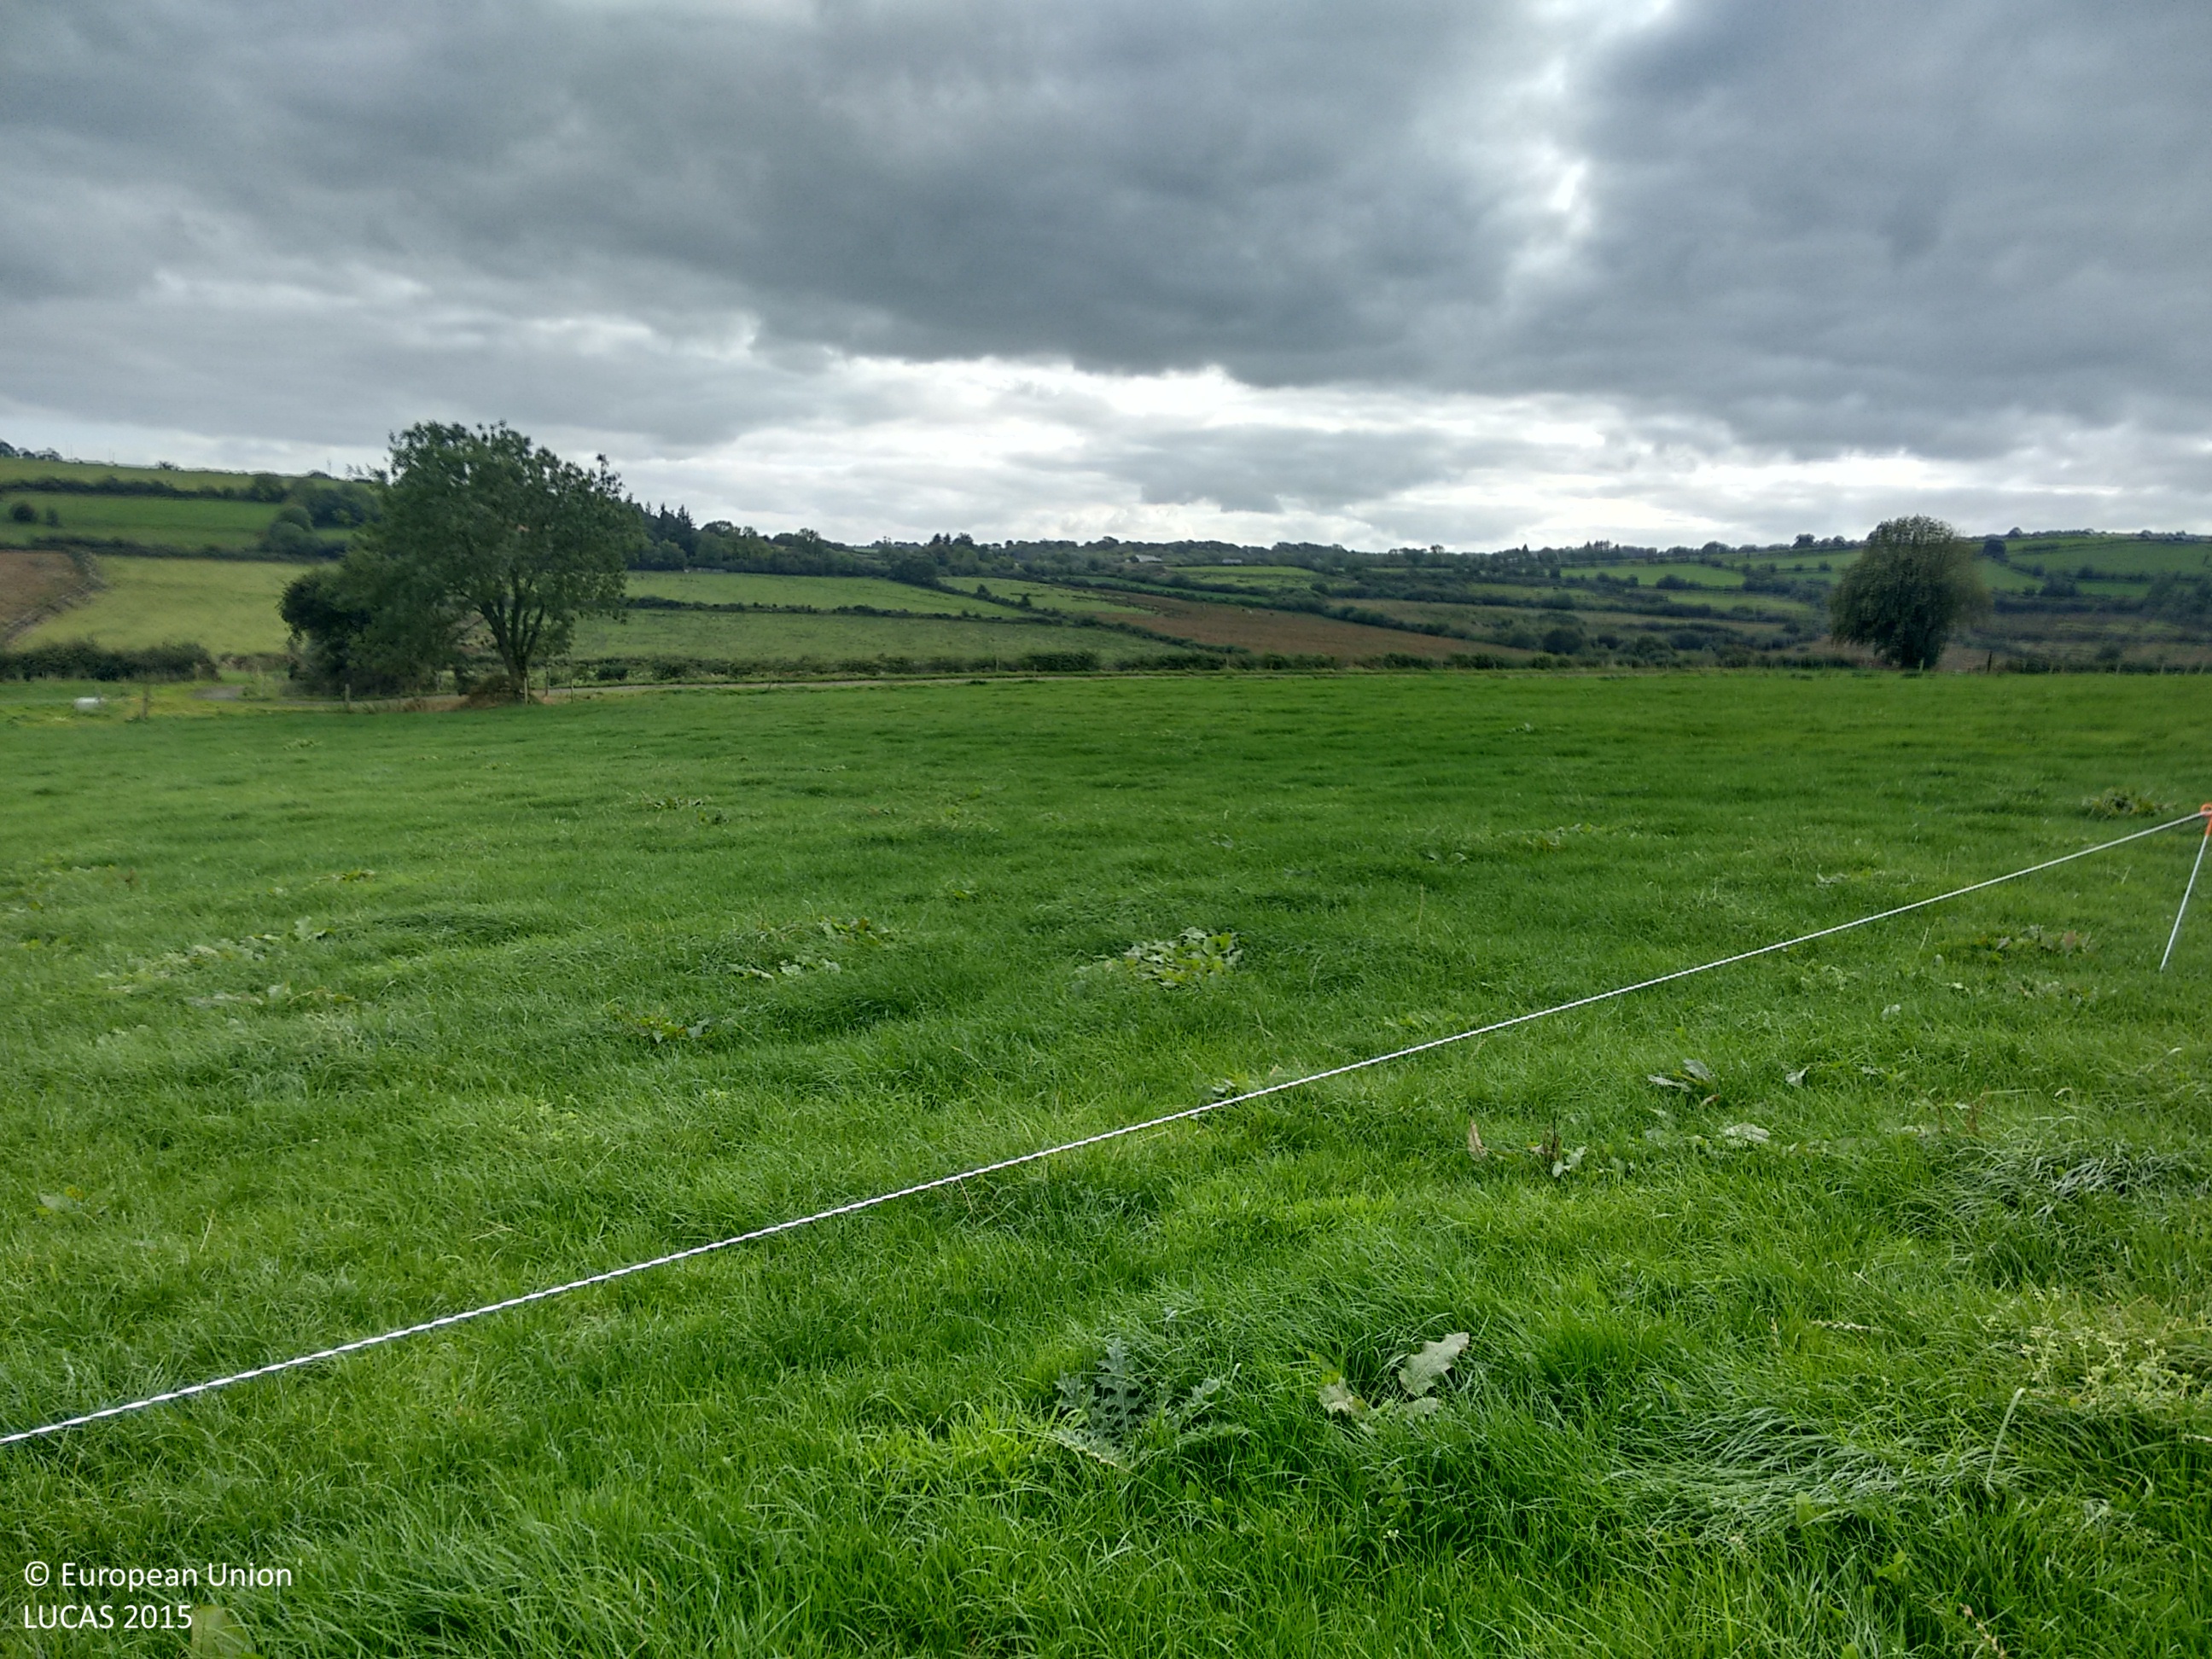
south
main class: Grassland
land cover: Grassland without tree/shrub cover
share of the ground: > 75 %
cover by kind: herbaceous plants 100 %
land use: Agriculture (excluding fallow land and kitchen gardens)
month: September
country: IE
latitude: 52.3332
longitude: -8.9209
